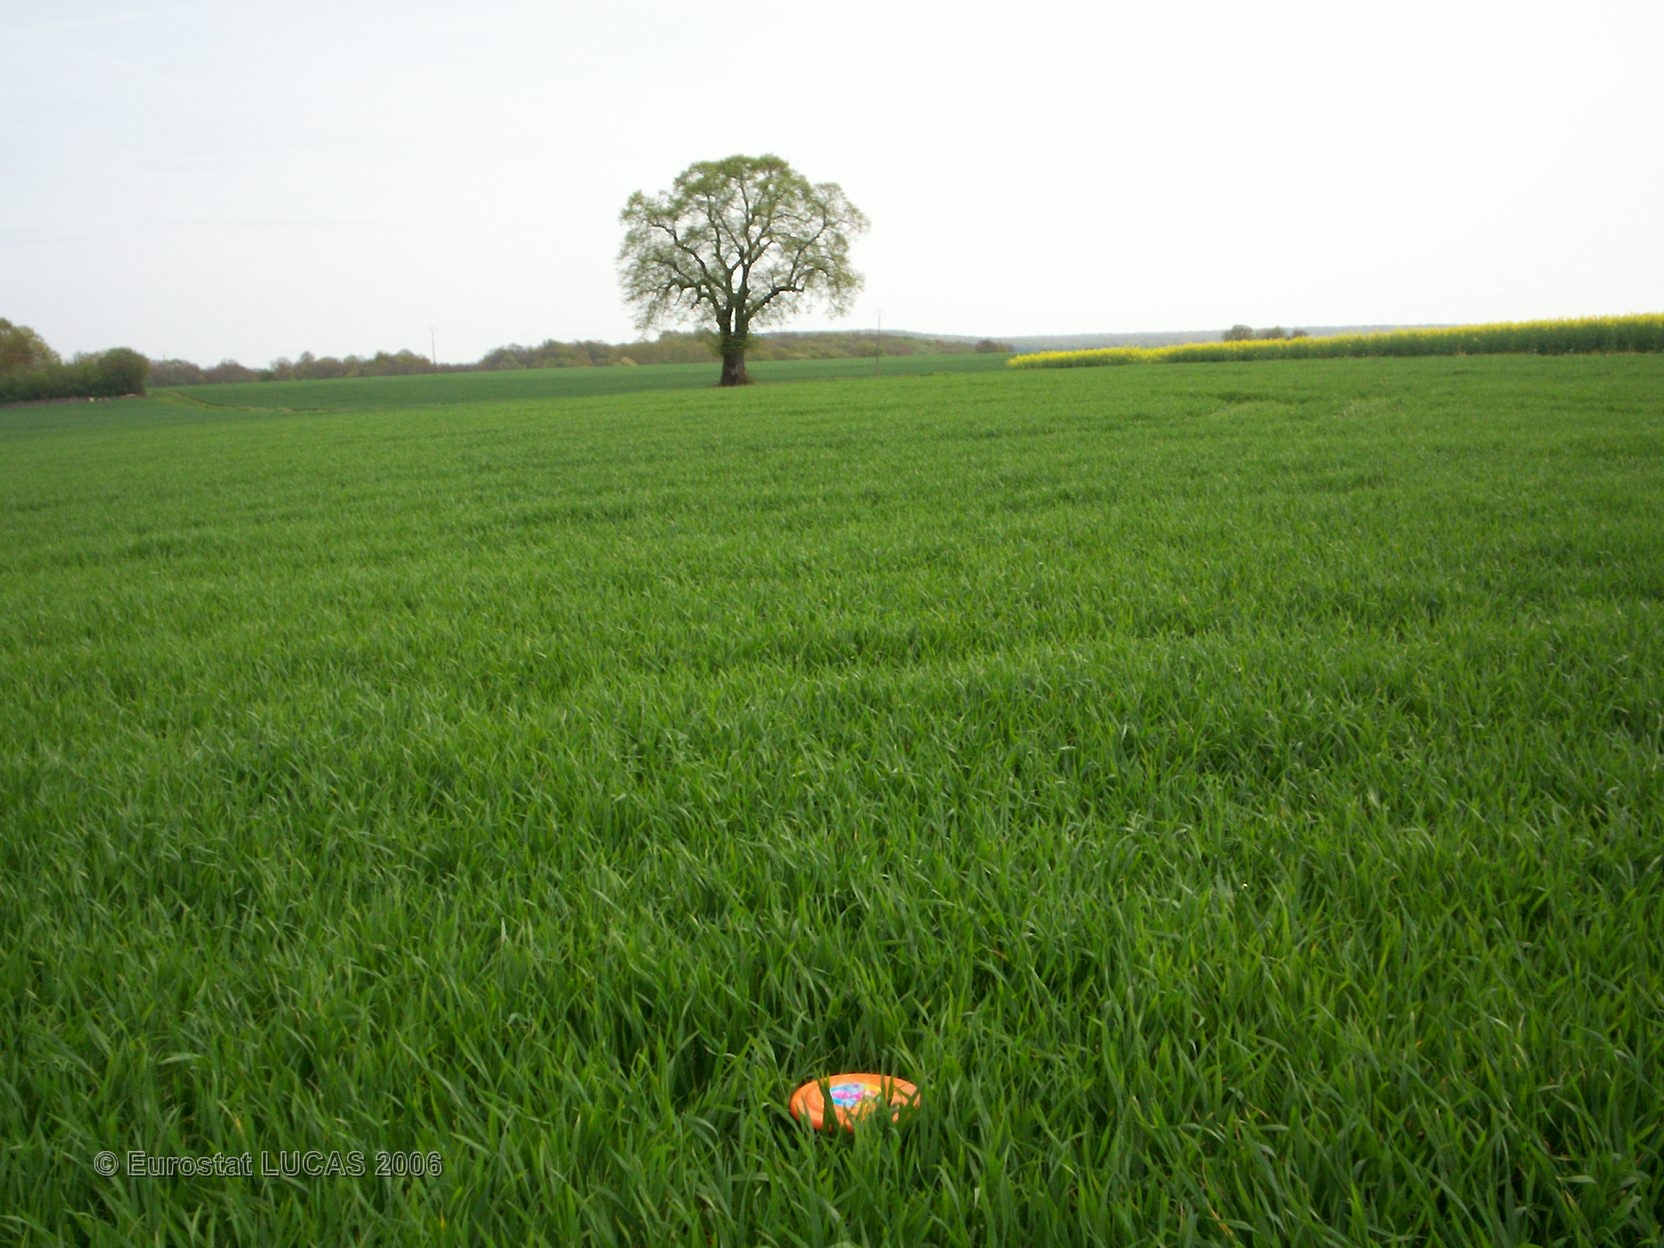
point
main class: Cropland
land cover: Common wheat
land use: Agriculture (excluding fallow land and kitchen gardens)
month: May
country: FR
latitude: 47.3194
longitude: 3.0758
